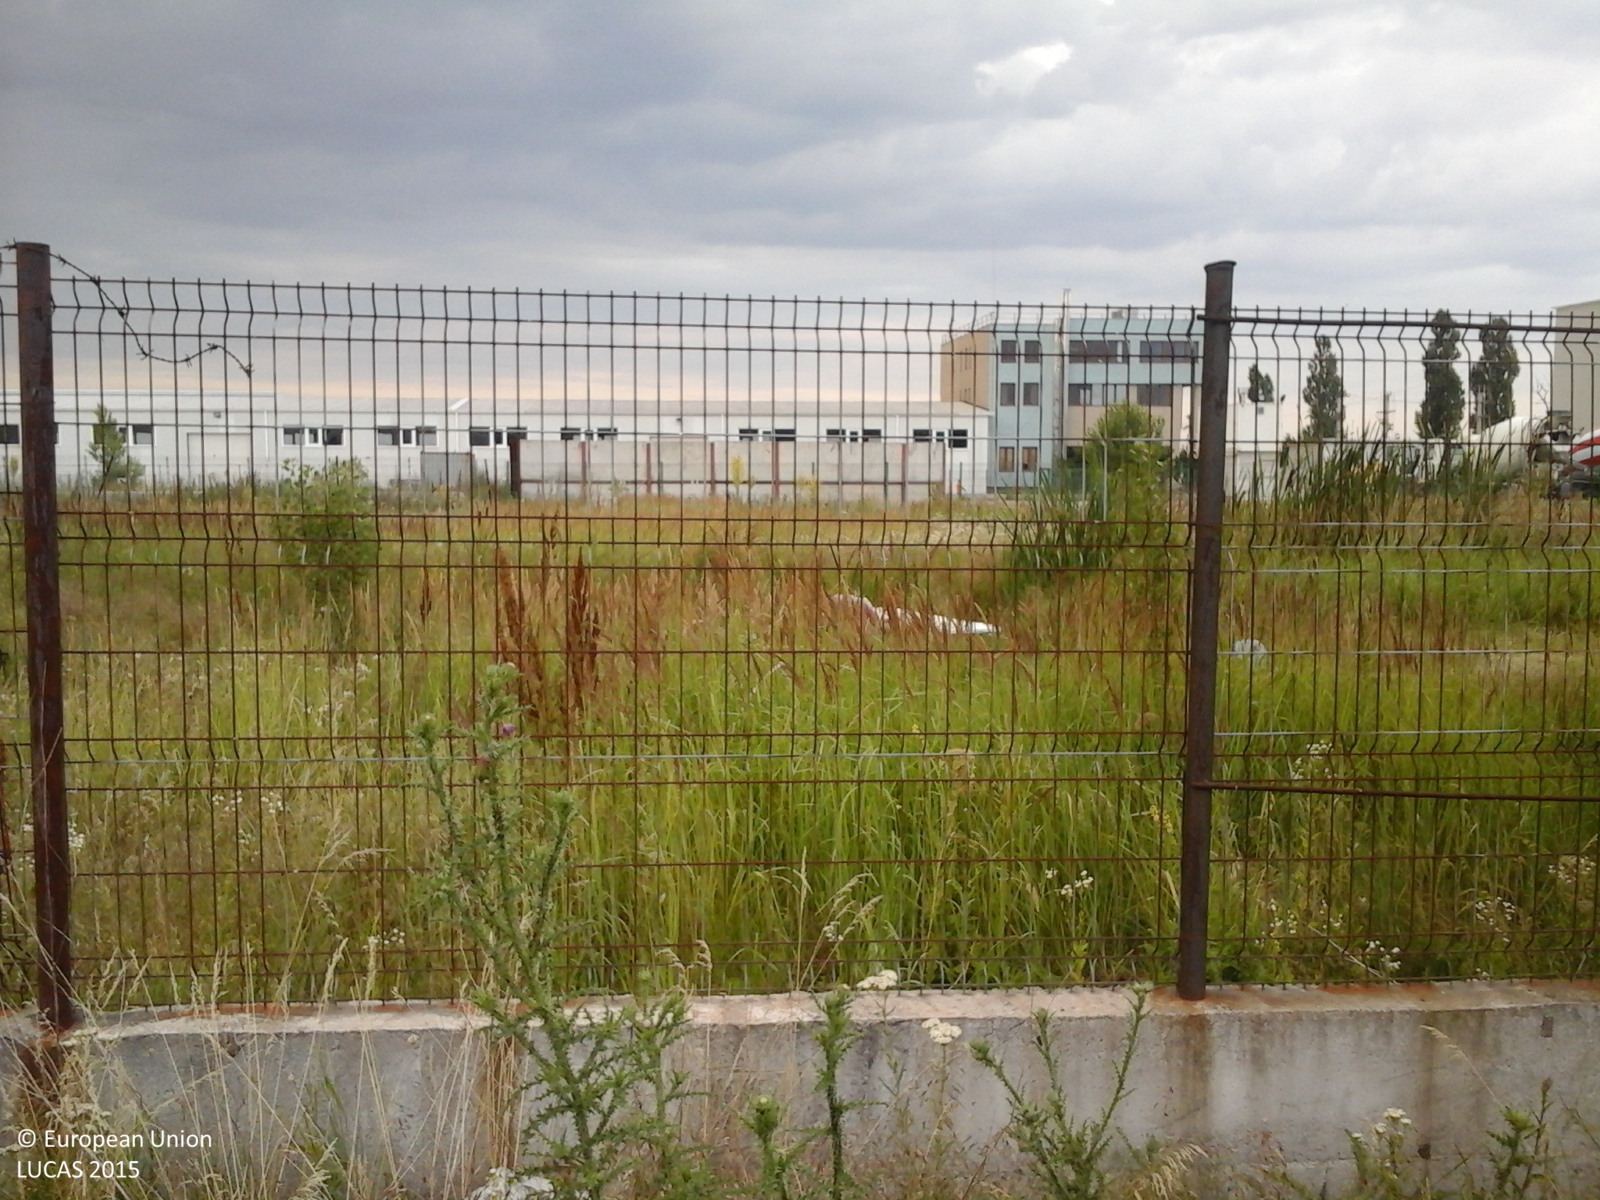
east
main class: Grassland
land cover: Spontaneously vegetated surfaces
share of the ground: > 75 %
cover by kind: herbaceous plants 100 %
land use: Fallow land
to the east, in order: Spontaneously vegetated surfaces; Artificial constructions in urban areas; Grassland without tree/shrub cover; Tracks; Grassland without tree/shrub cover; Abandoned hedges; Artificial constructions in urban areas
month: June
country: RO
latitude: 44.4541
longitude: 26.2579
